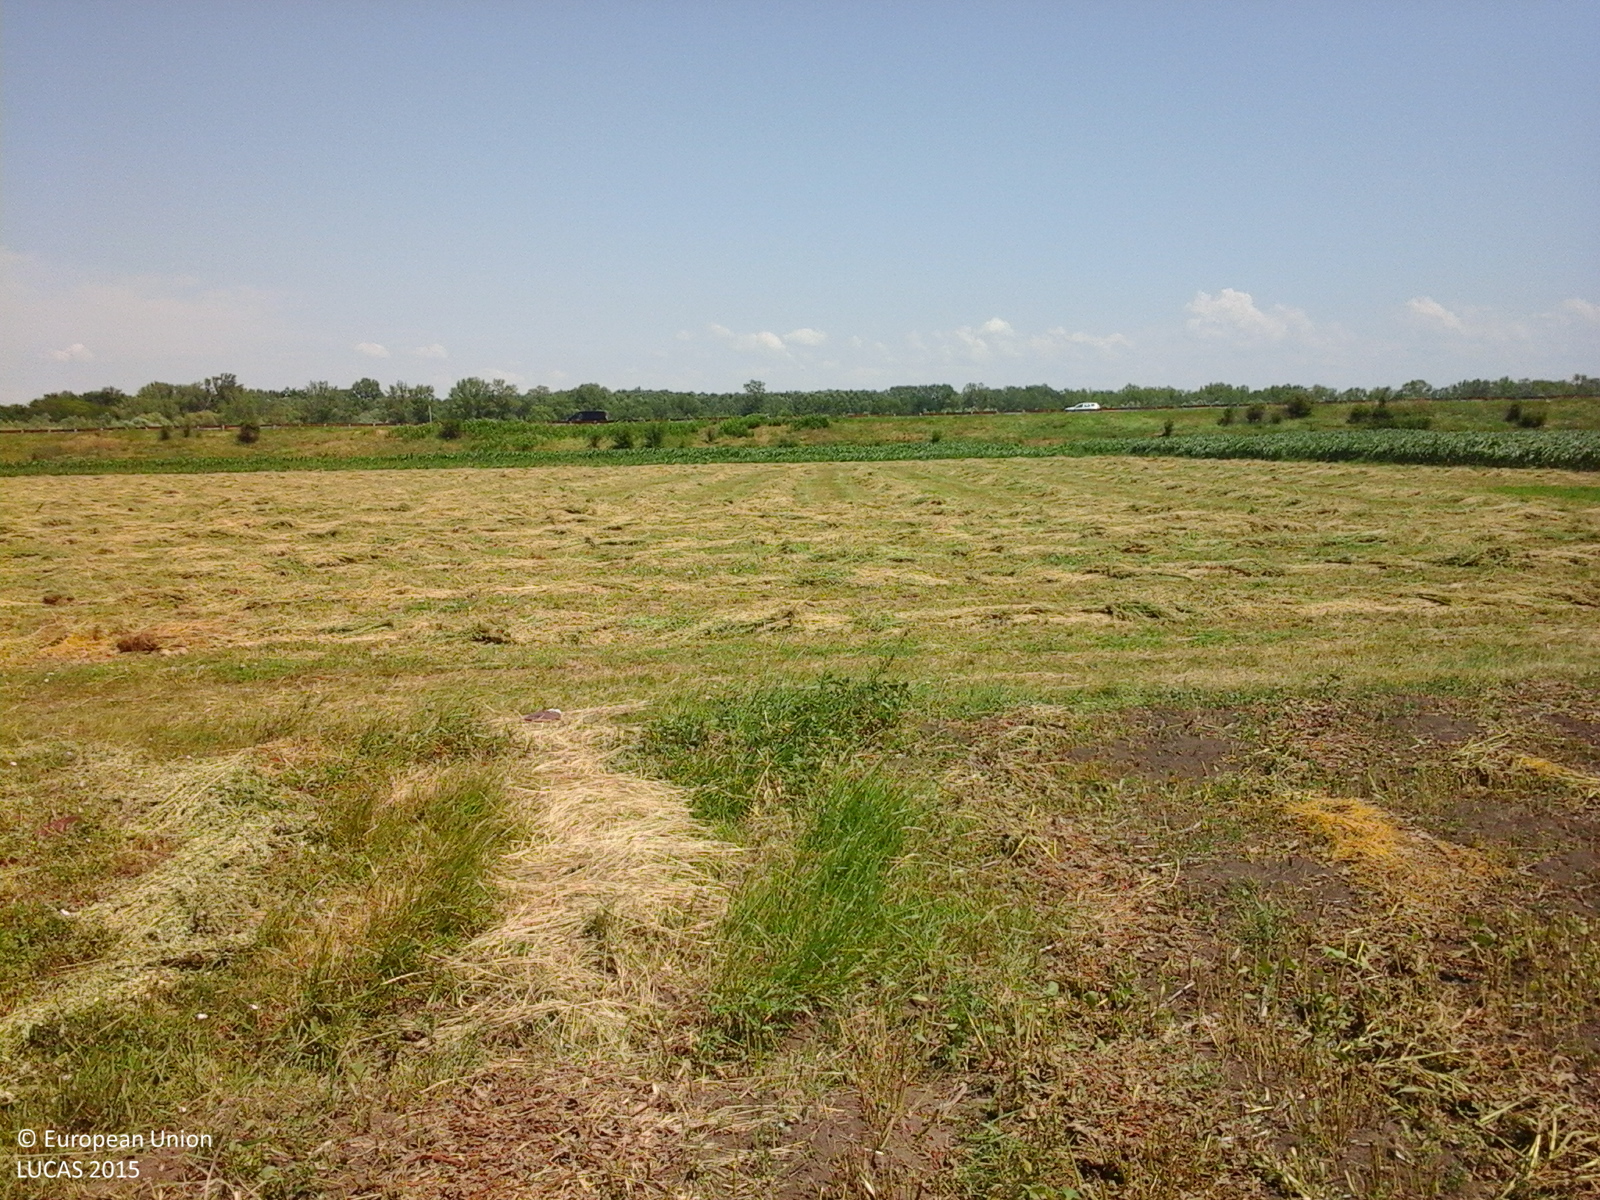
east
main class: Cropland
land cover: Lucerne
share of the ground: > 75 %
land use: Agriculture (excluding fallow land and kitchen gardens)
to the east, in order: Lucerne; Tracks; Lucerne; Maize; Grassland without tree/shrub cover; Fences; Paved roads, cycling and walking lanes; Fences; Grassland without tree/shrub cover; Tracks; Grass margins; Maize
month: June
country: RO
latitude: 46.8359
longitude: 28.1080
